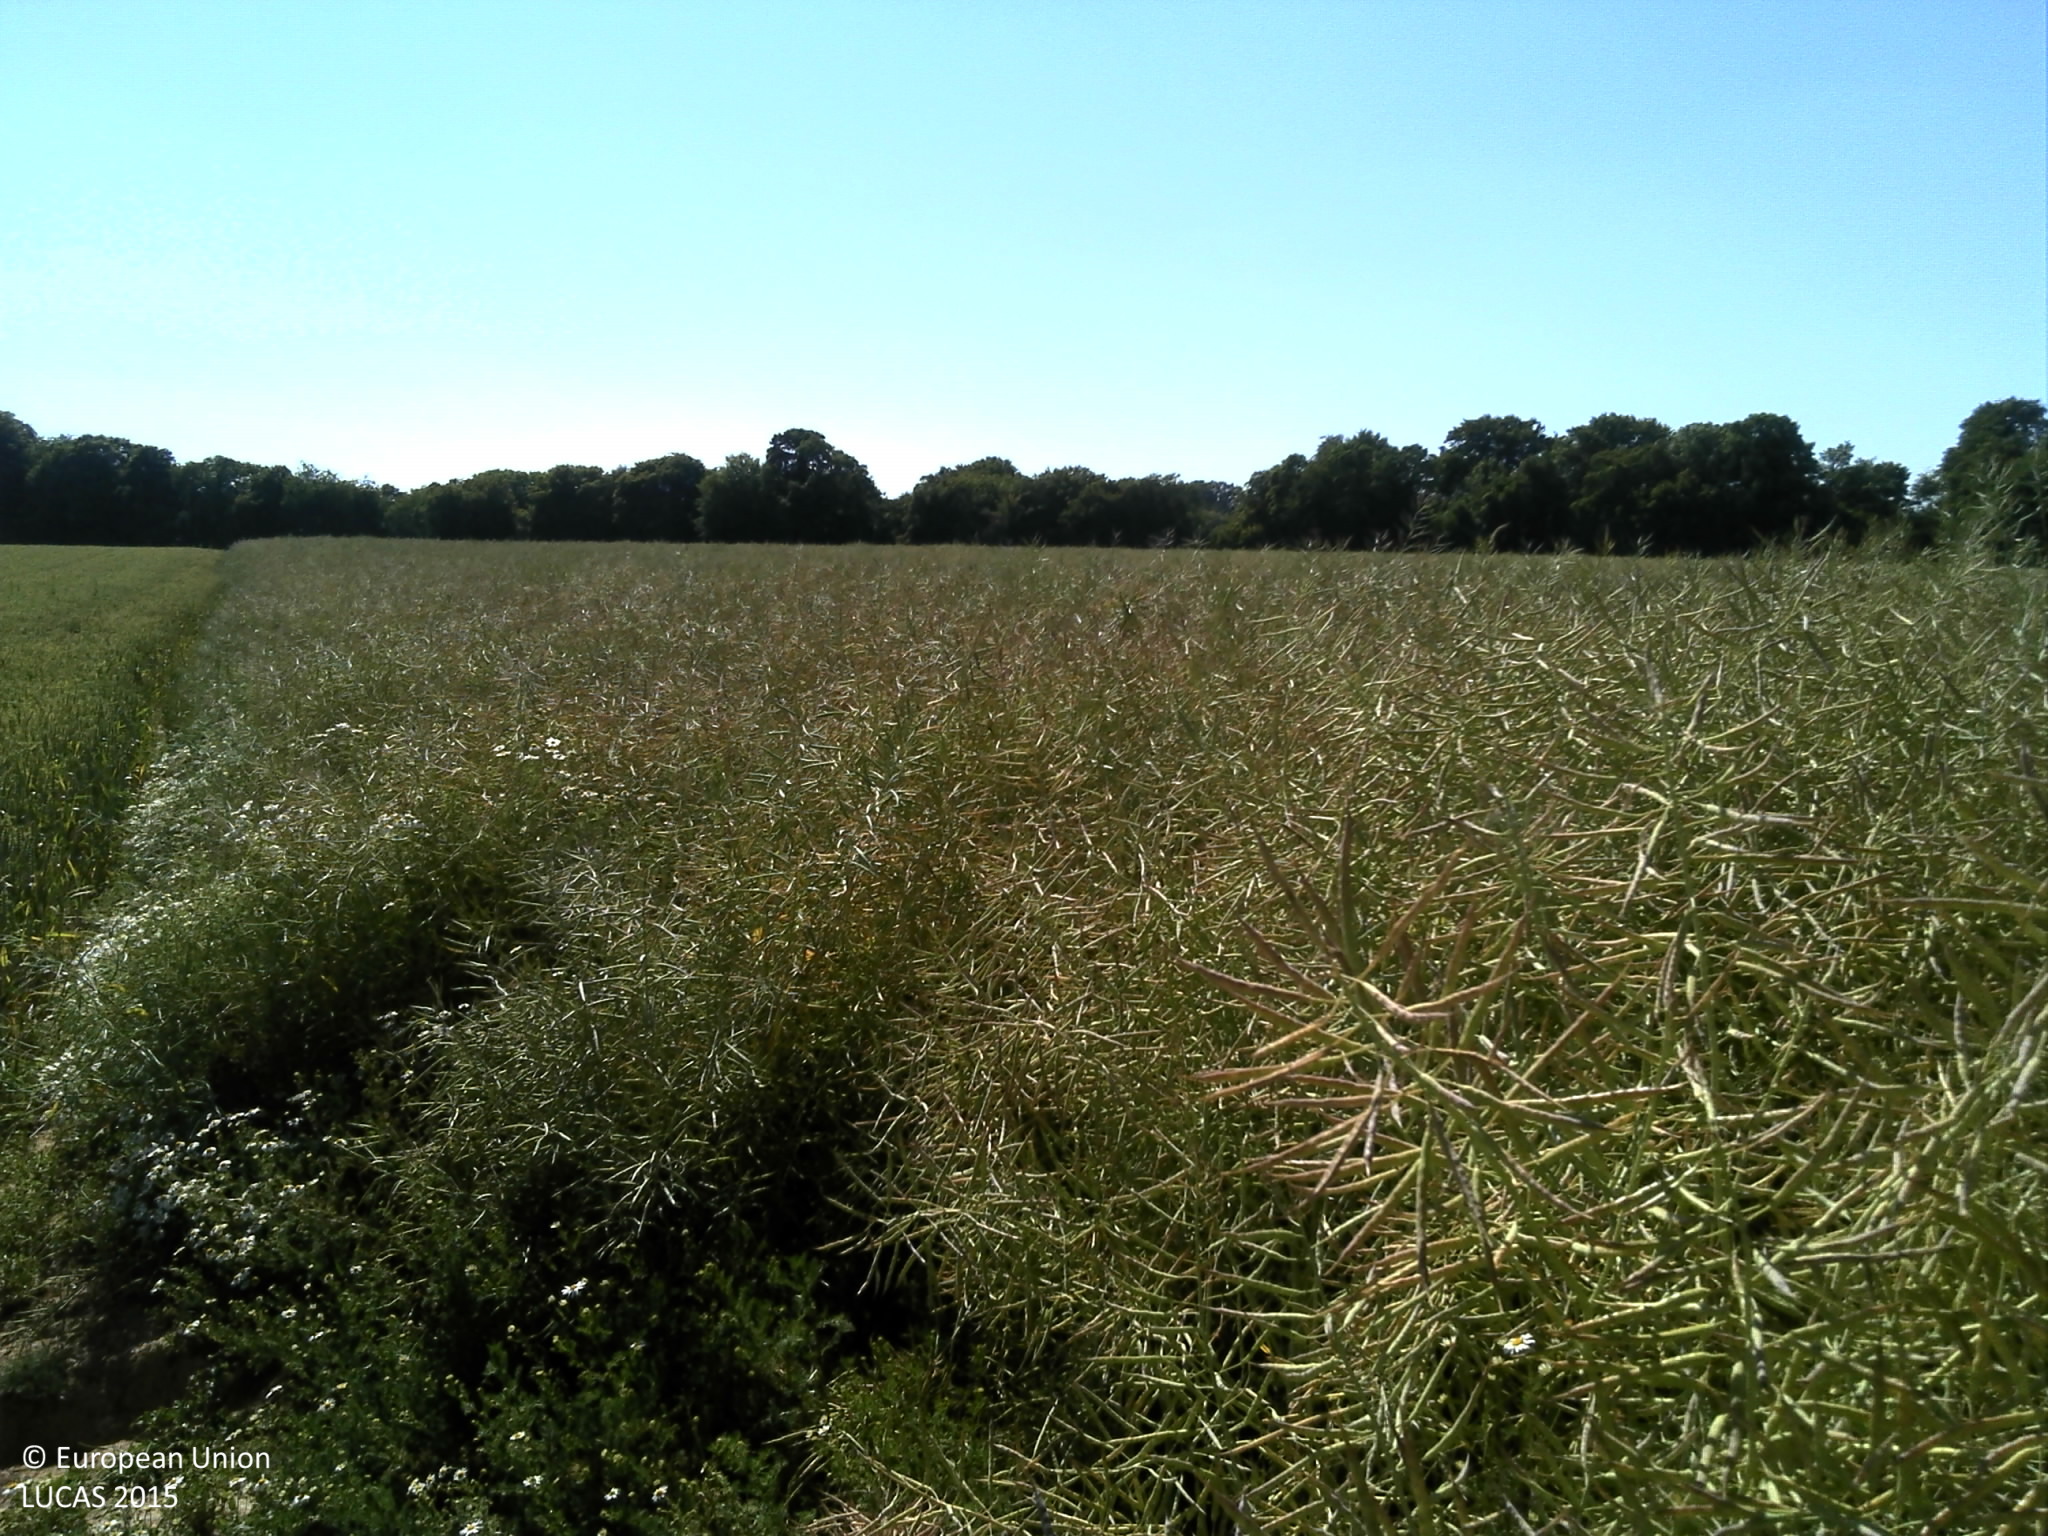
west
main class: Cropland
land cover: Rape and turnip rape
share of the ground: > 75 %
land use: Agriculture (excluding fallow land and kitchen gardens)
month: June
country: FR
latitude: 49.4124
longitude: 6.0160
